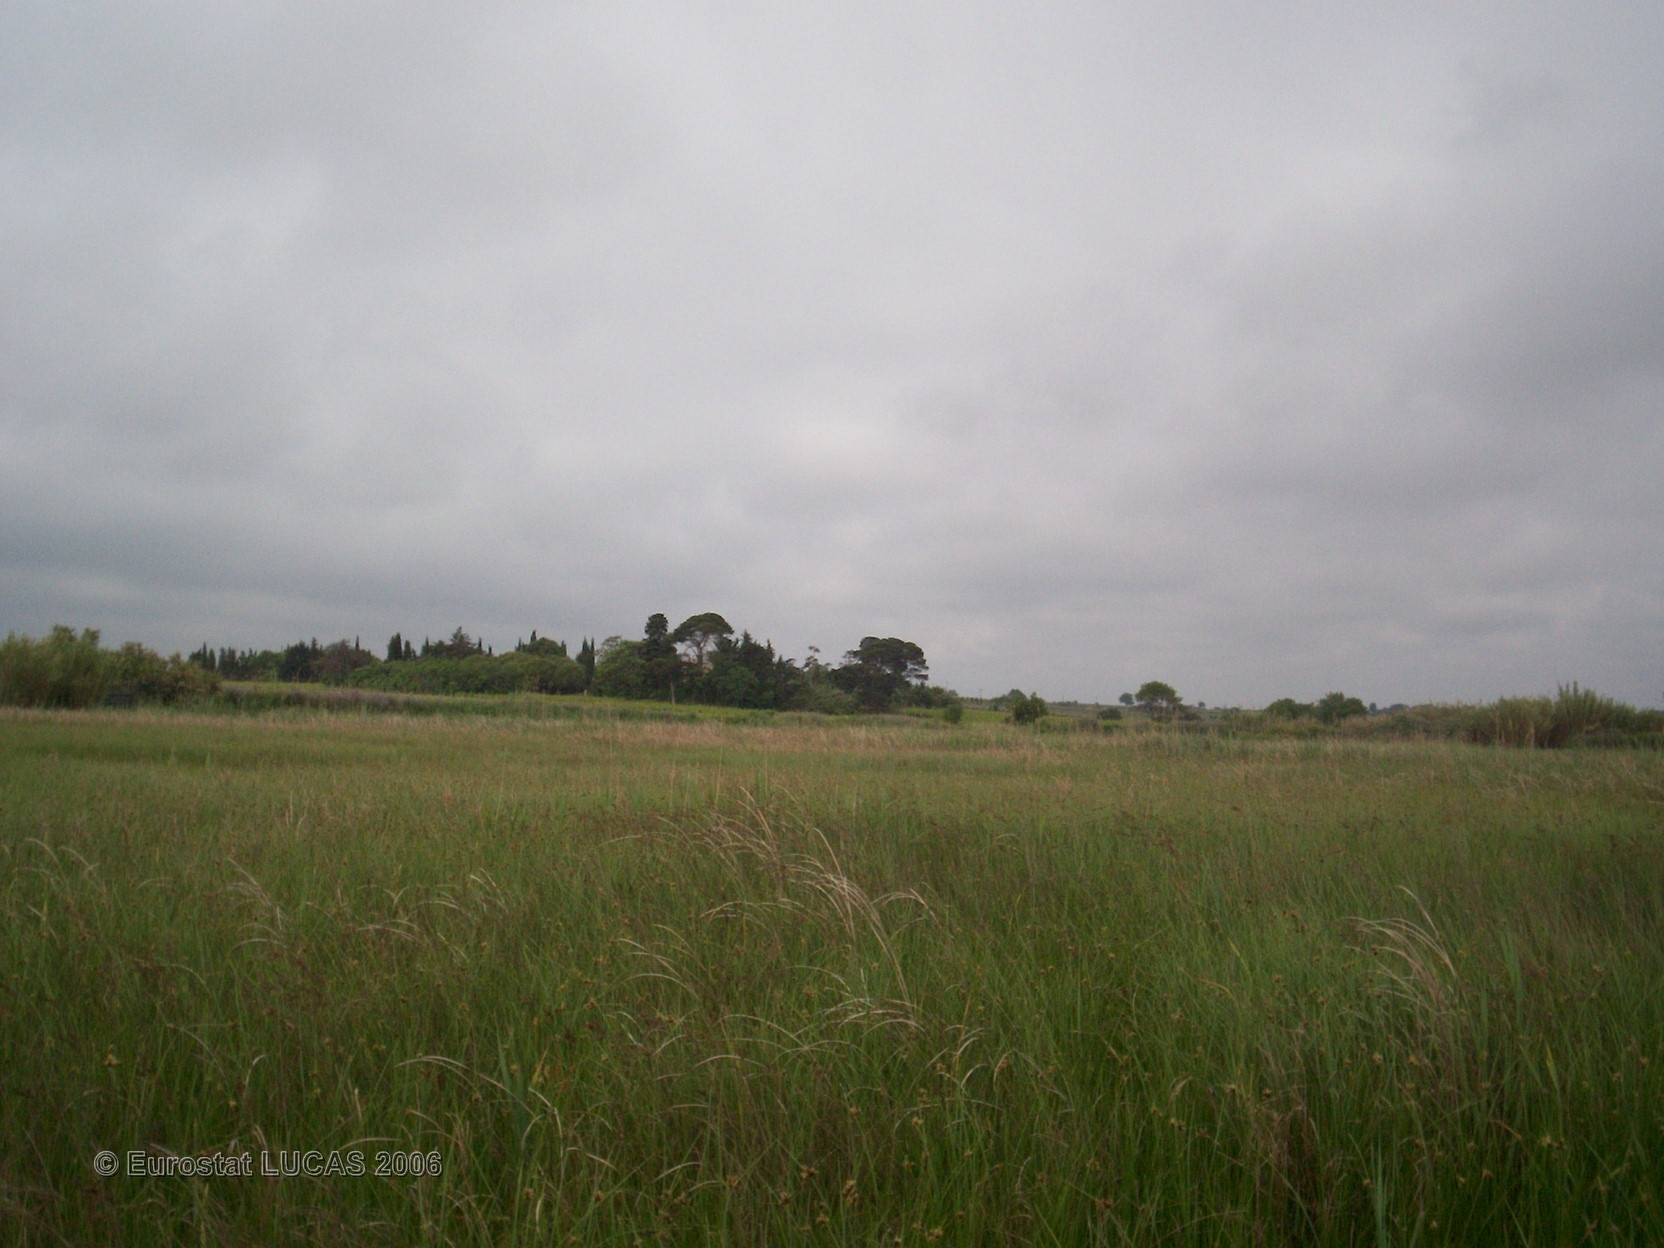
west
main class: Grassland
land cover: Grassland without tree/shrub cover
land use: Unused
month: May
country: FR
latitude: 43.3330
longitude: 3.5101
